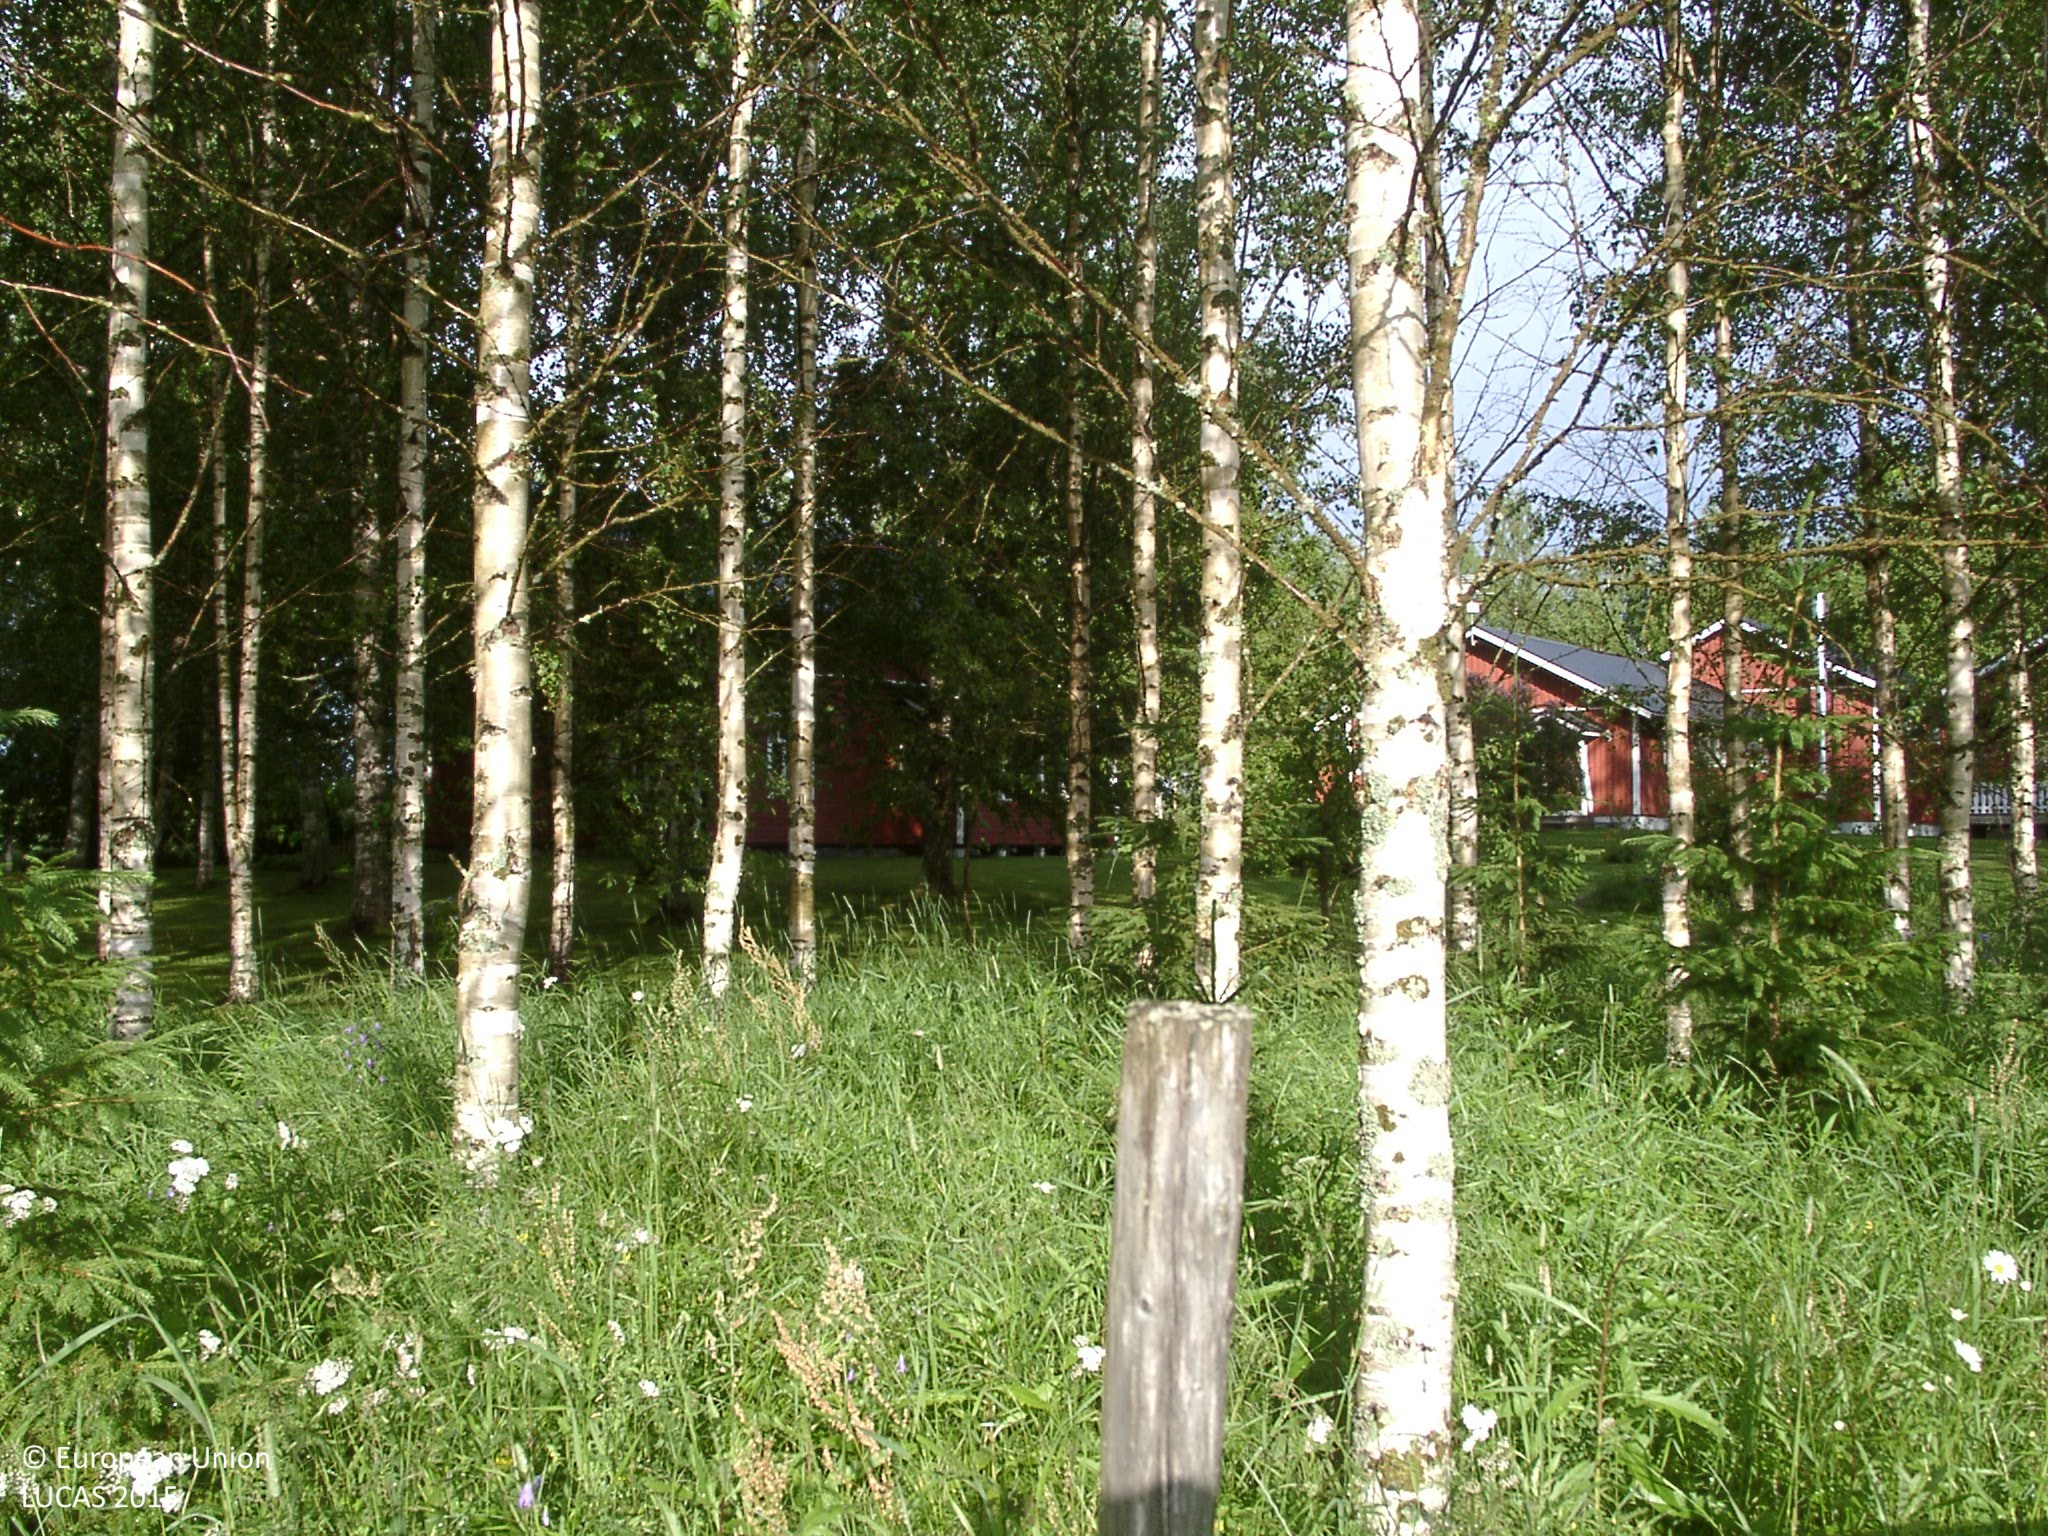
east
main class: Cropland
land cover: Oats
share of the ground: > 75 %
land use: Agriculture (excluding fallow land and kitchen gardens)
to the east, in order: Oats; Fences; Broadleaved woodland; Artificial constructions in urban areas; Abandoned hedges; Ditches and canals; Grass margins; Oats
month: July
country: FI
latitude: 62.2028
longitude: 25.1965
